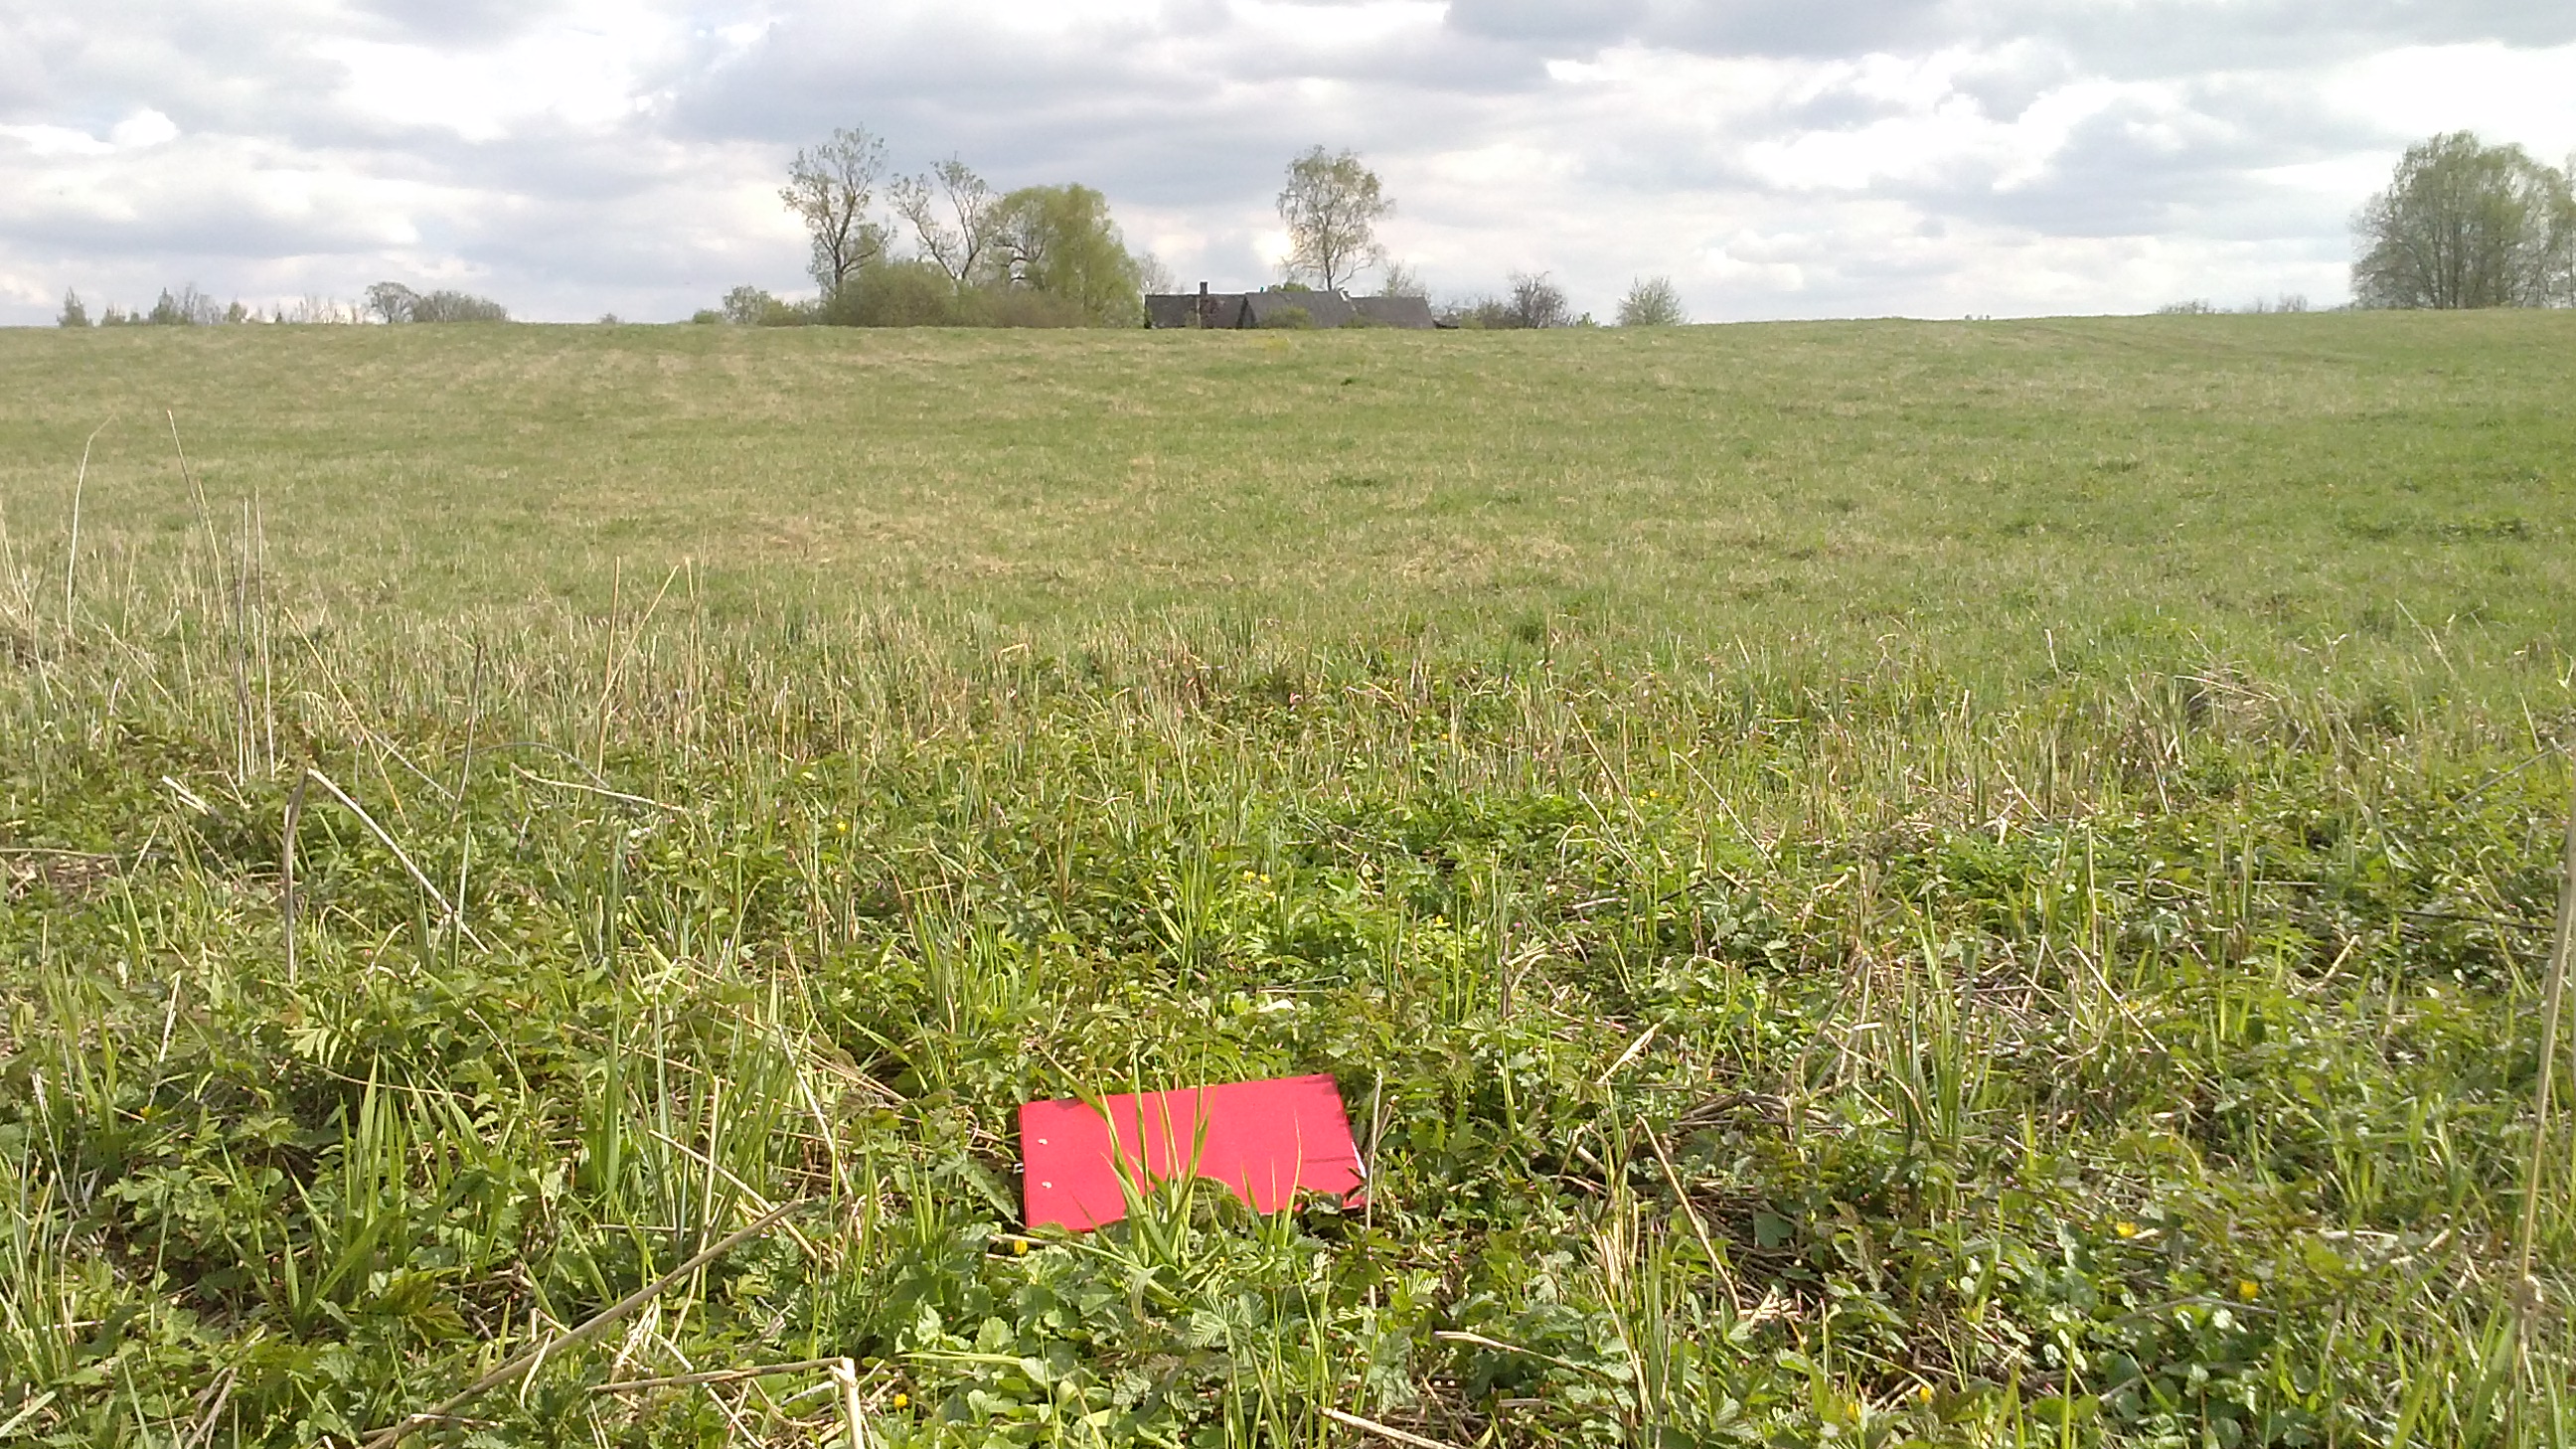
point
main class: Grassland
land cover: Grassland without tree/shrub cover
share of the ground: > 75 %
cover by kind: herbaceous plants 100 %
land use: Agriculture (excluding fallow land and kitchen gardens)
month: May
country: LV
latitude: 55.9452
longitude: 27.3912
